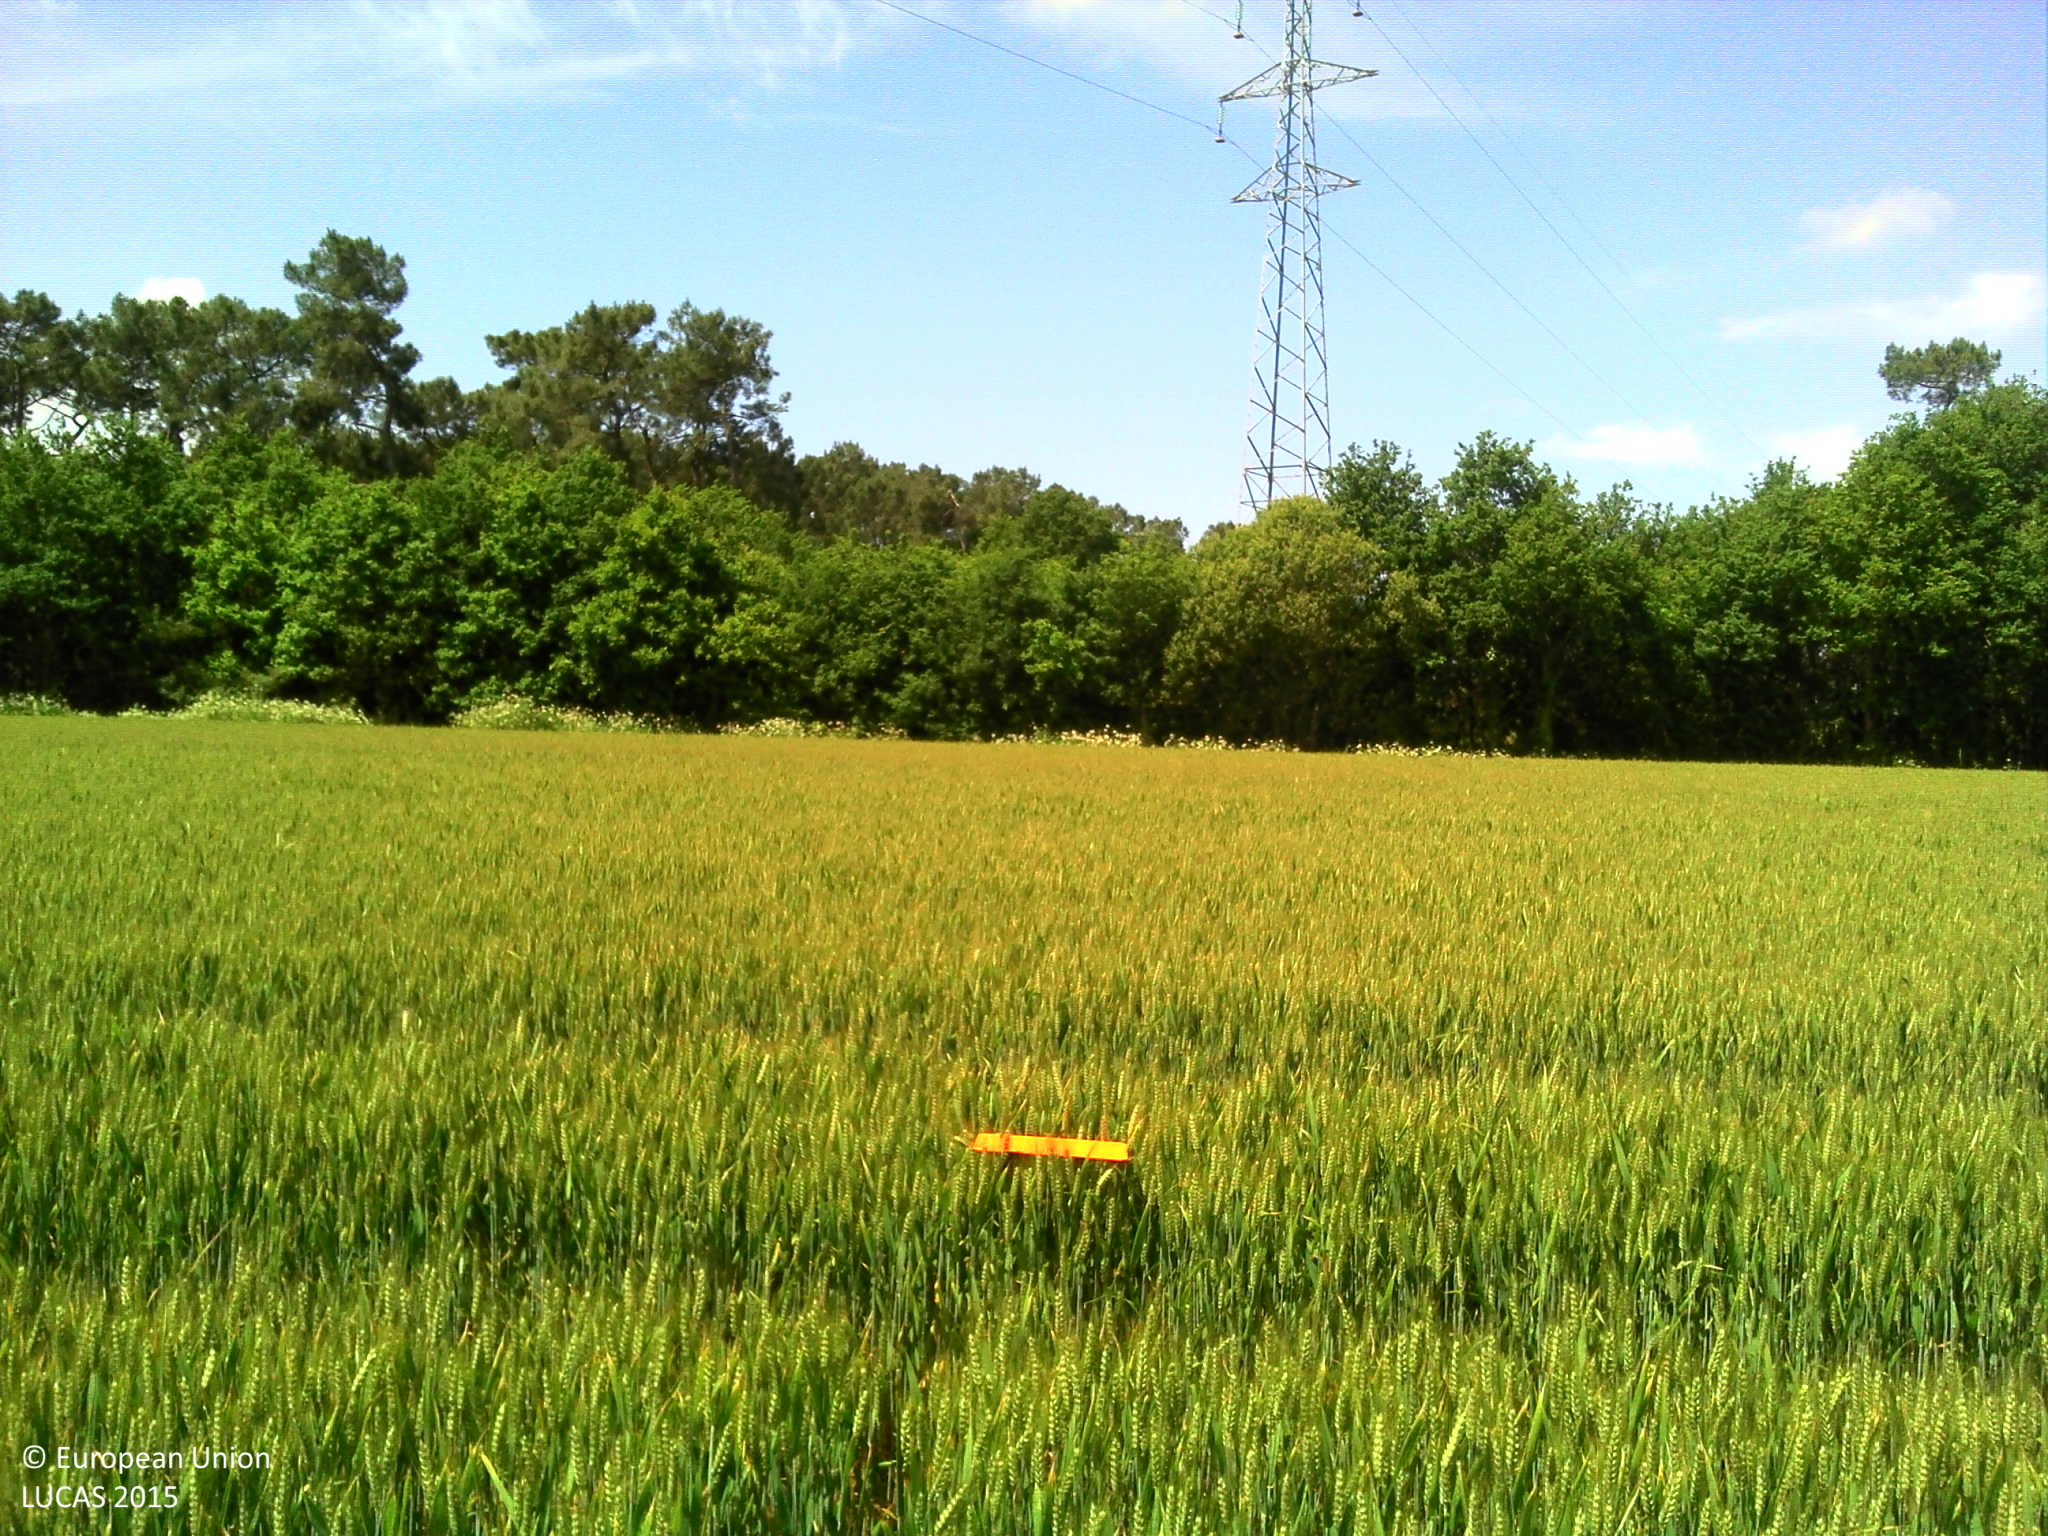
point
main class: Cropland
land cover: Common wheat
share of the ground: > 75 %
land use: Agriculture (excluding fallow land and kitchen gardens)
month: June
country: FR
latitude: 46.9154
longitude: -1.9553
